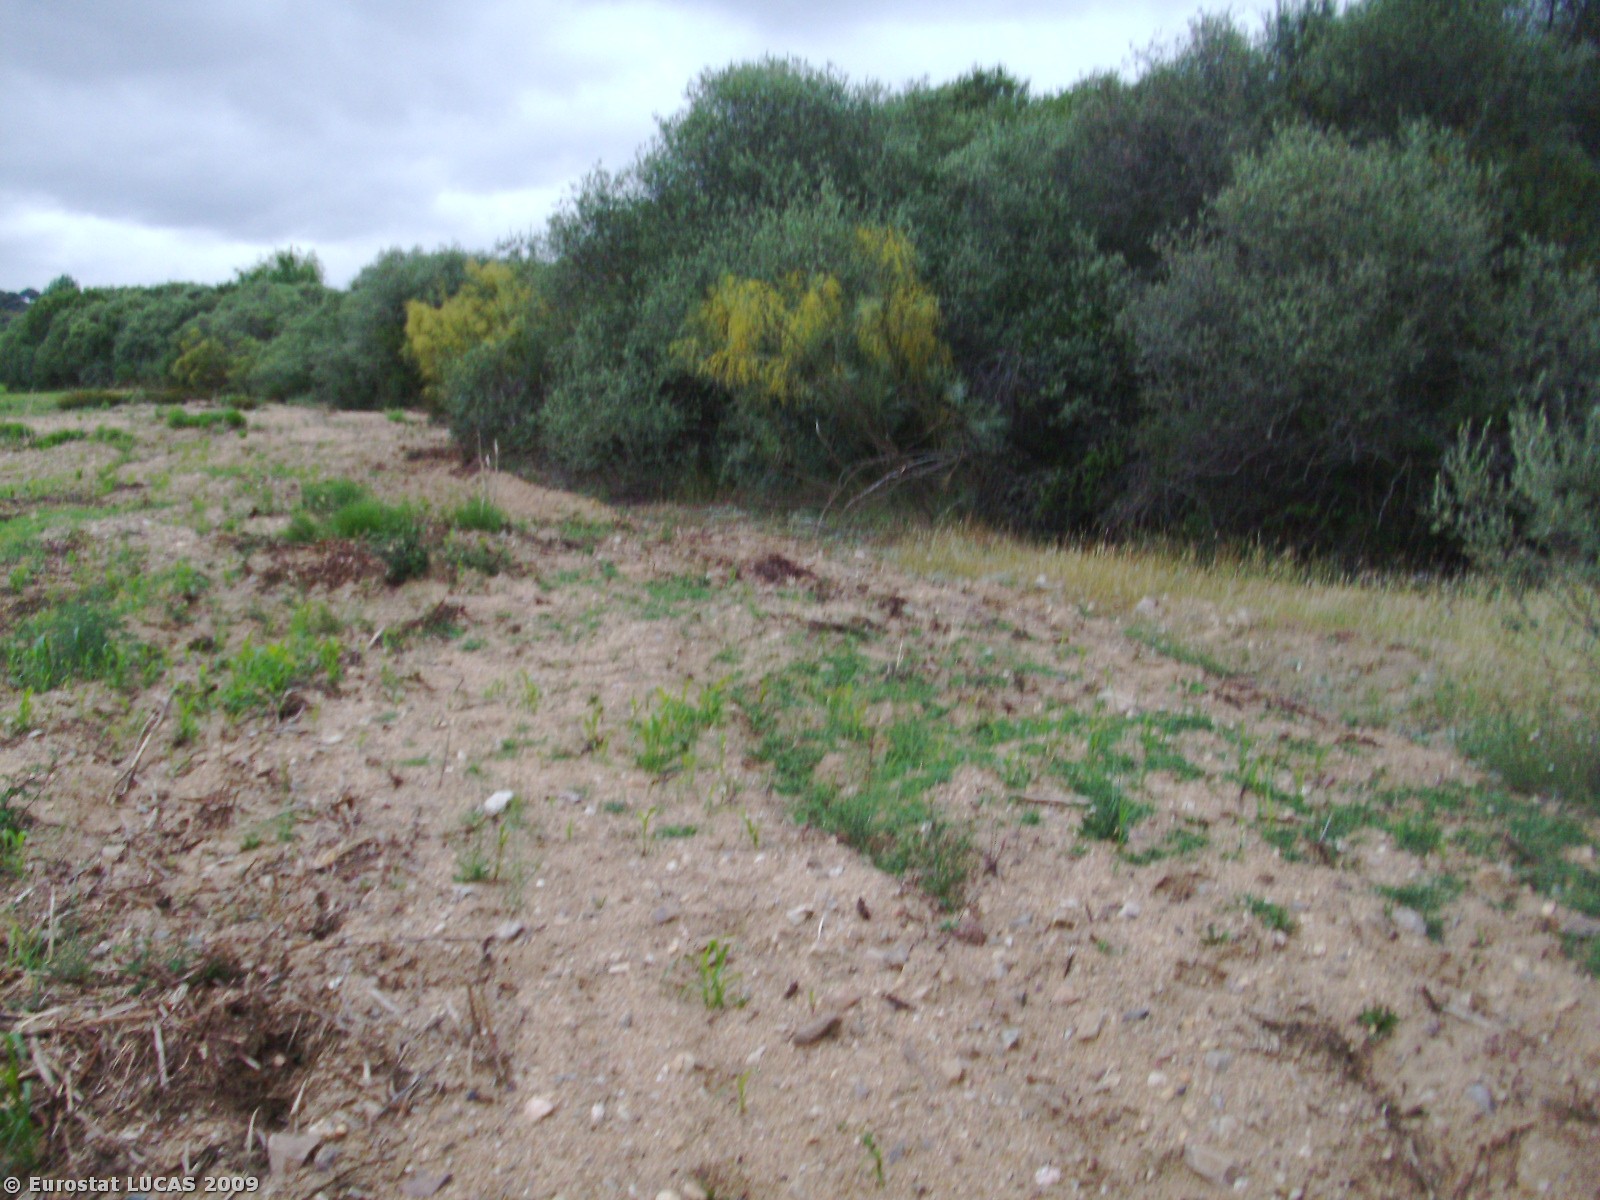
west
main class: Woodland
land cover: Broadleaved woodland
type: mesophytic deciduous forest
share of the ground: > 75 %
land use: Forestry
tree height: > 5 m
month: June
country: PT
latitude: 39.7896
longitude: -7.3904
